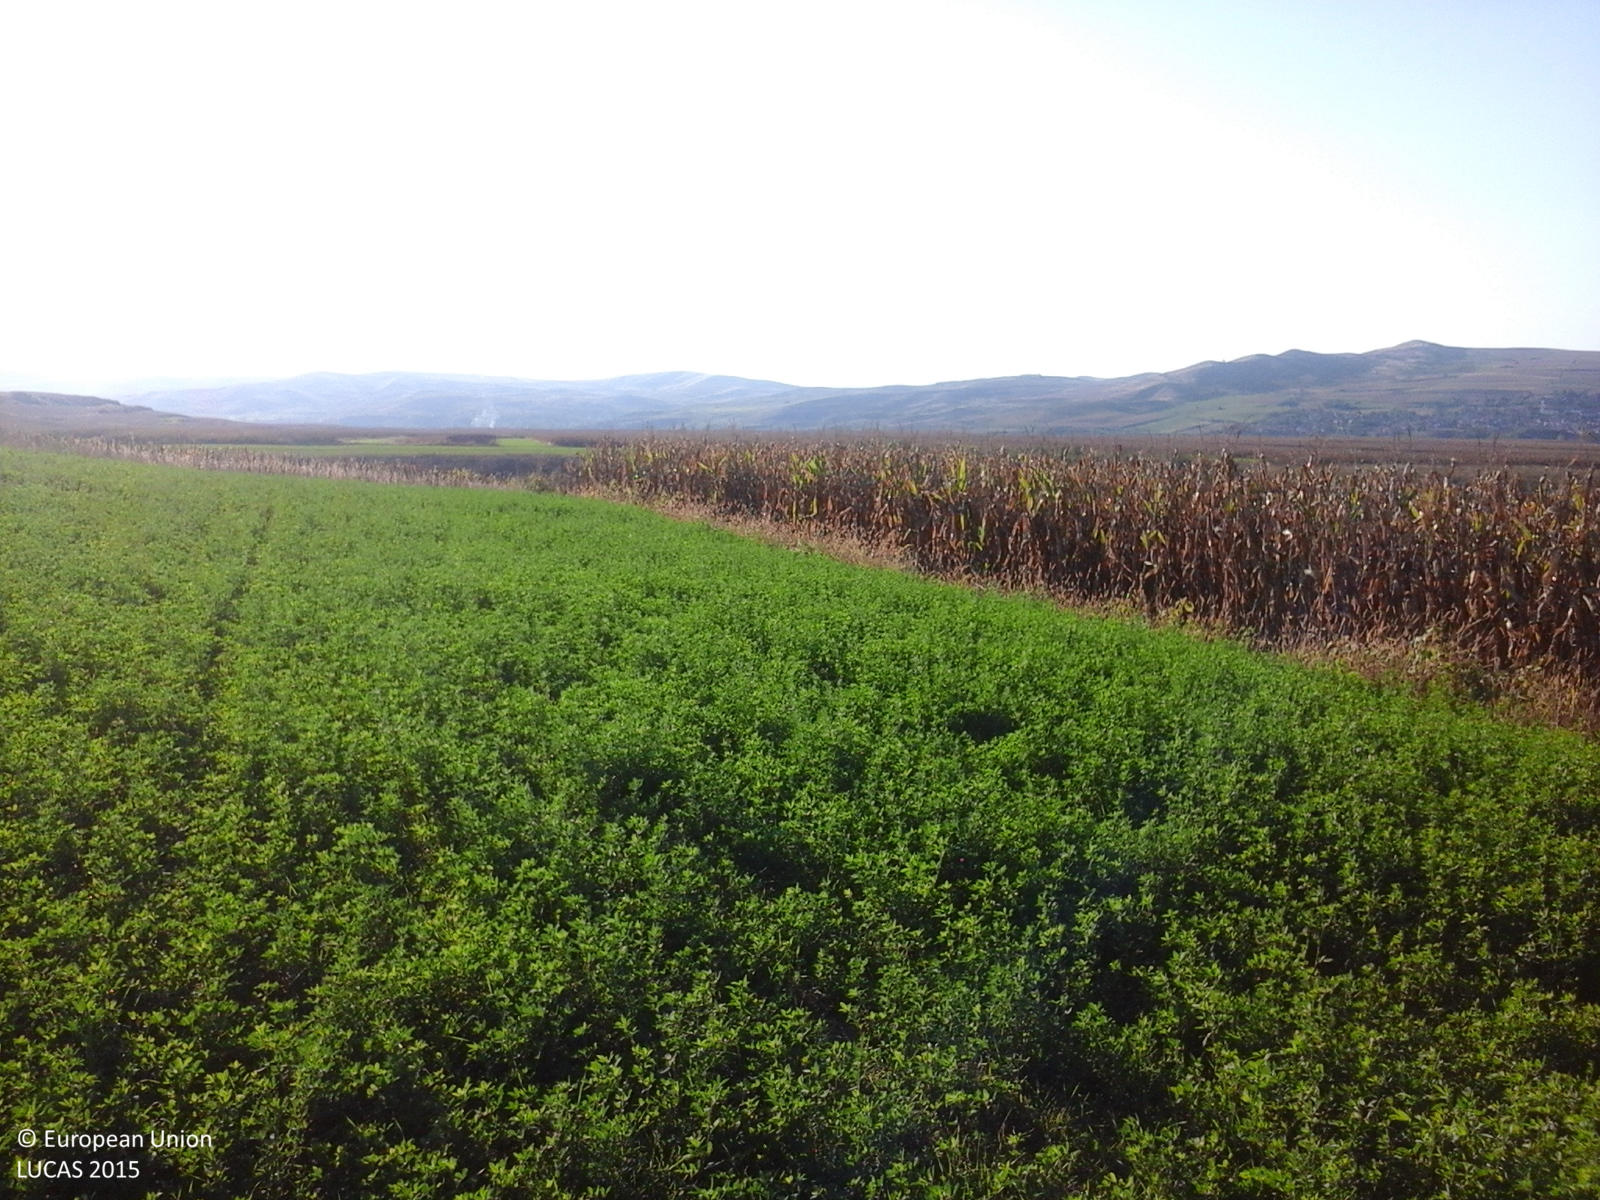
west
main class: Cropland
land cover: Lucerne
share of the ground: > 75 %
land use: Agriculture (excluding fallow land and kitchen gardens)
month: October
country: RO
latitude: 46.2127
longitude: 23.9831
